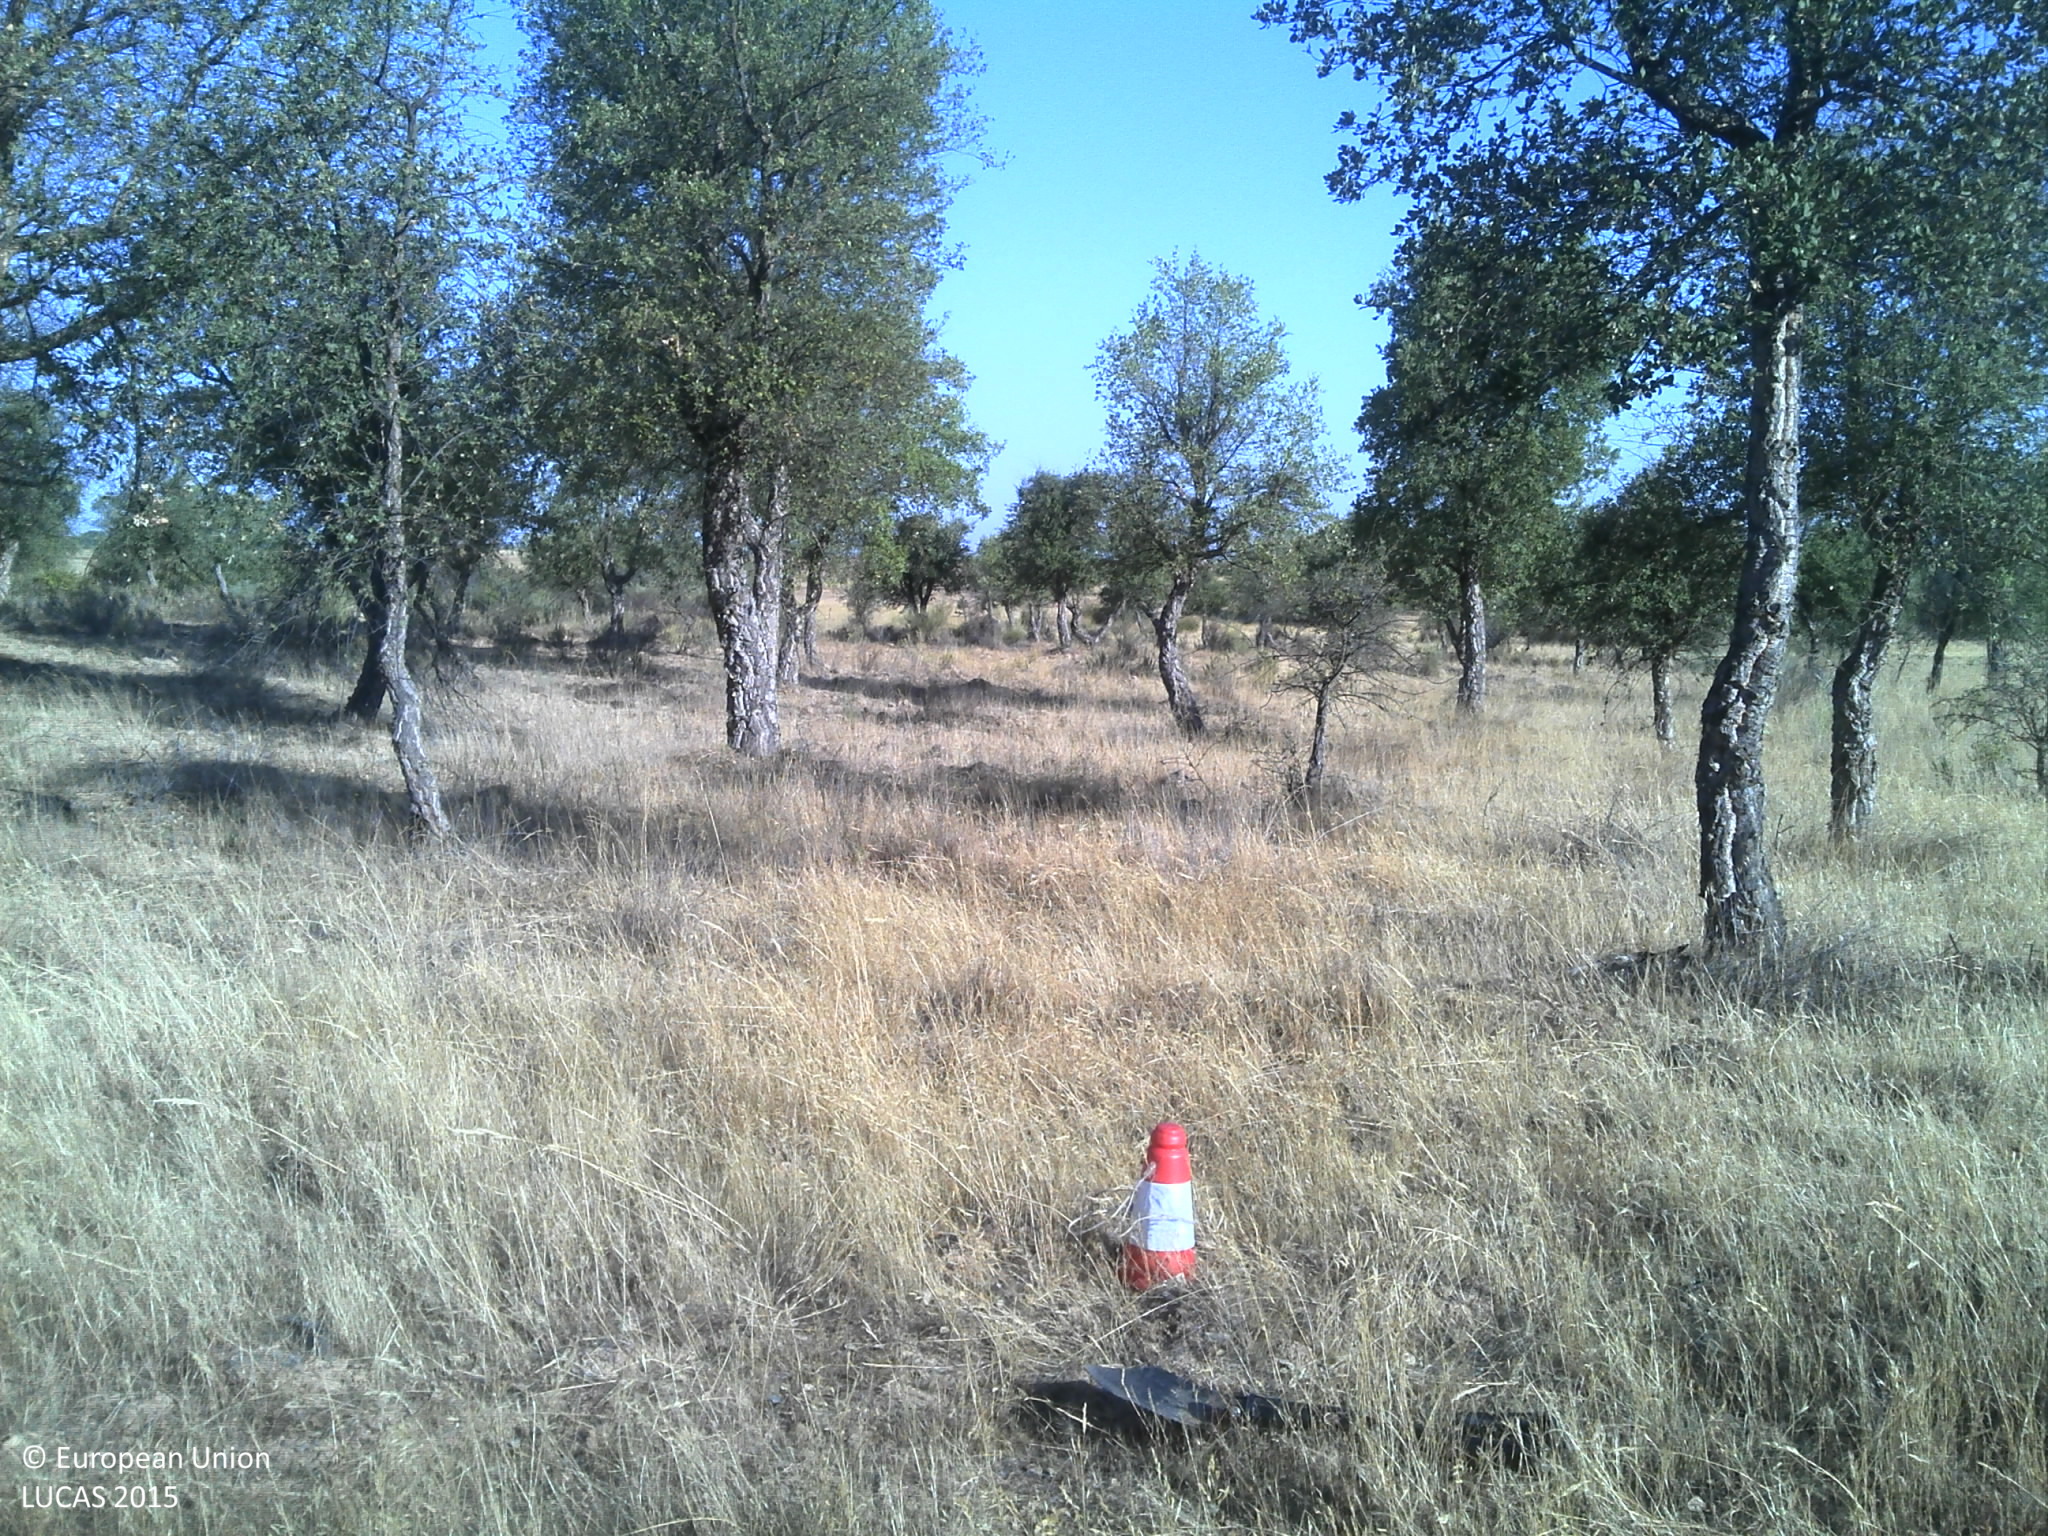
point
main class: Woodland
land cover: Broadleaved woodland
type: broadleaved evergreen forest
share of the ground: 25 - 50 %
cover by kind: broadleaved forest trees 50 %, herbaceous plants 40 %, shrubs 5 %, unconsolidated bare surface 5 %
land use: Forestry
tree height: > 5 m
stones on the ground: 10 - 25 %
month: June
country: PT
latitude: 39.8184
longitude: -7.2307
